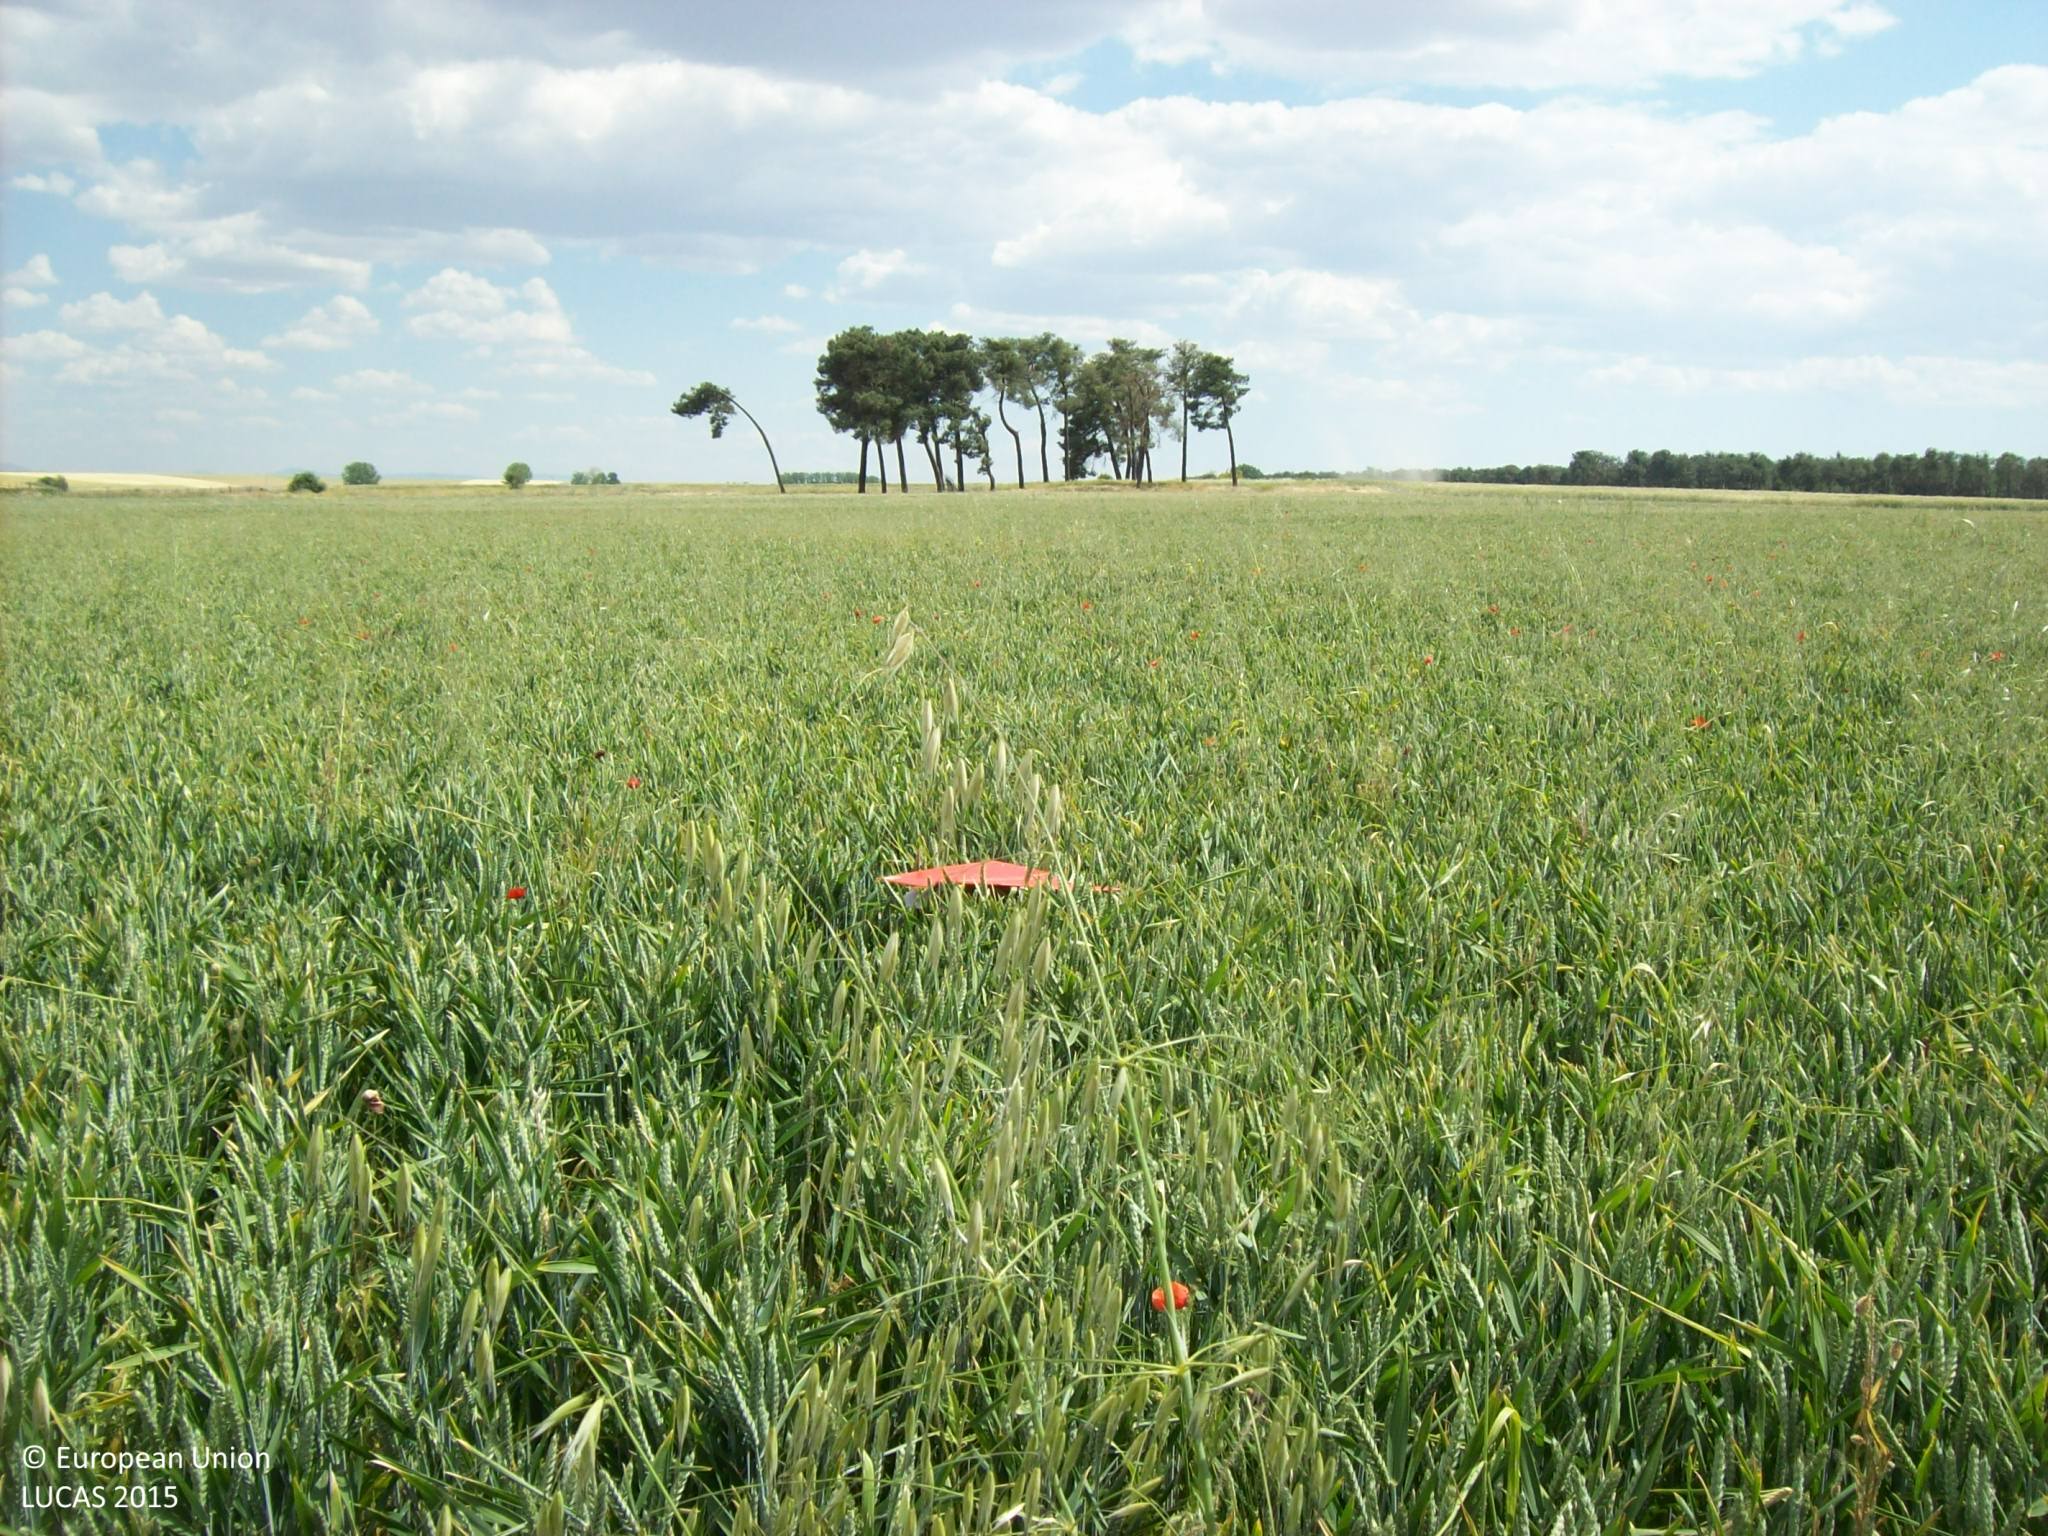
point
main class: Cropland
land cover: Common wheat
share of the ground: > 75 %
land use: Agriculture (excluding fallow land and kitchen gardens)
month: June
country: ES
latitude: 41.1376
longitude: -4.5581
